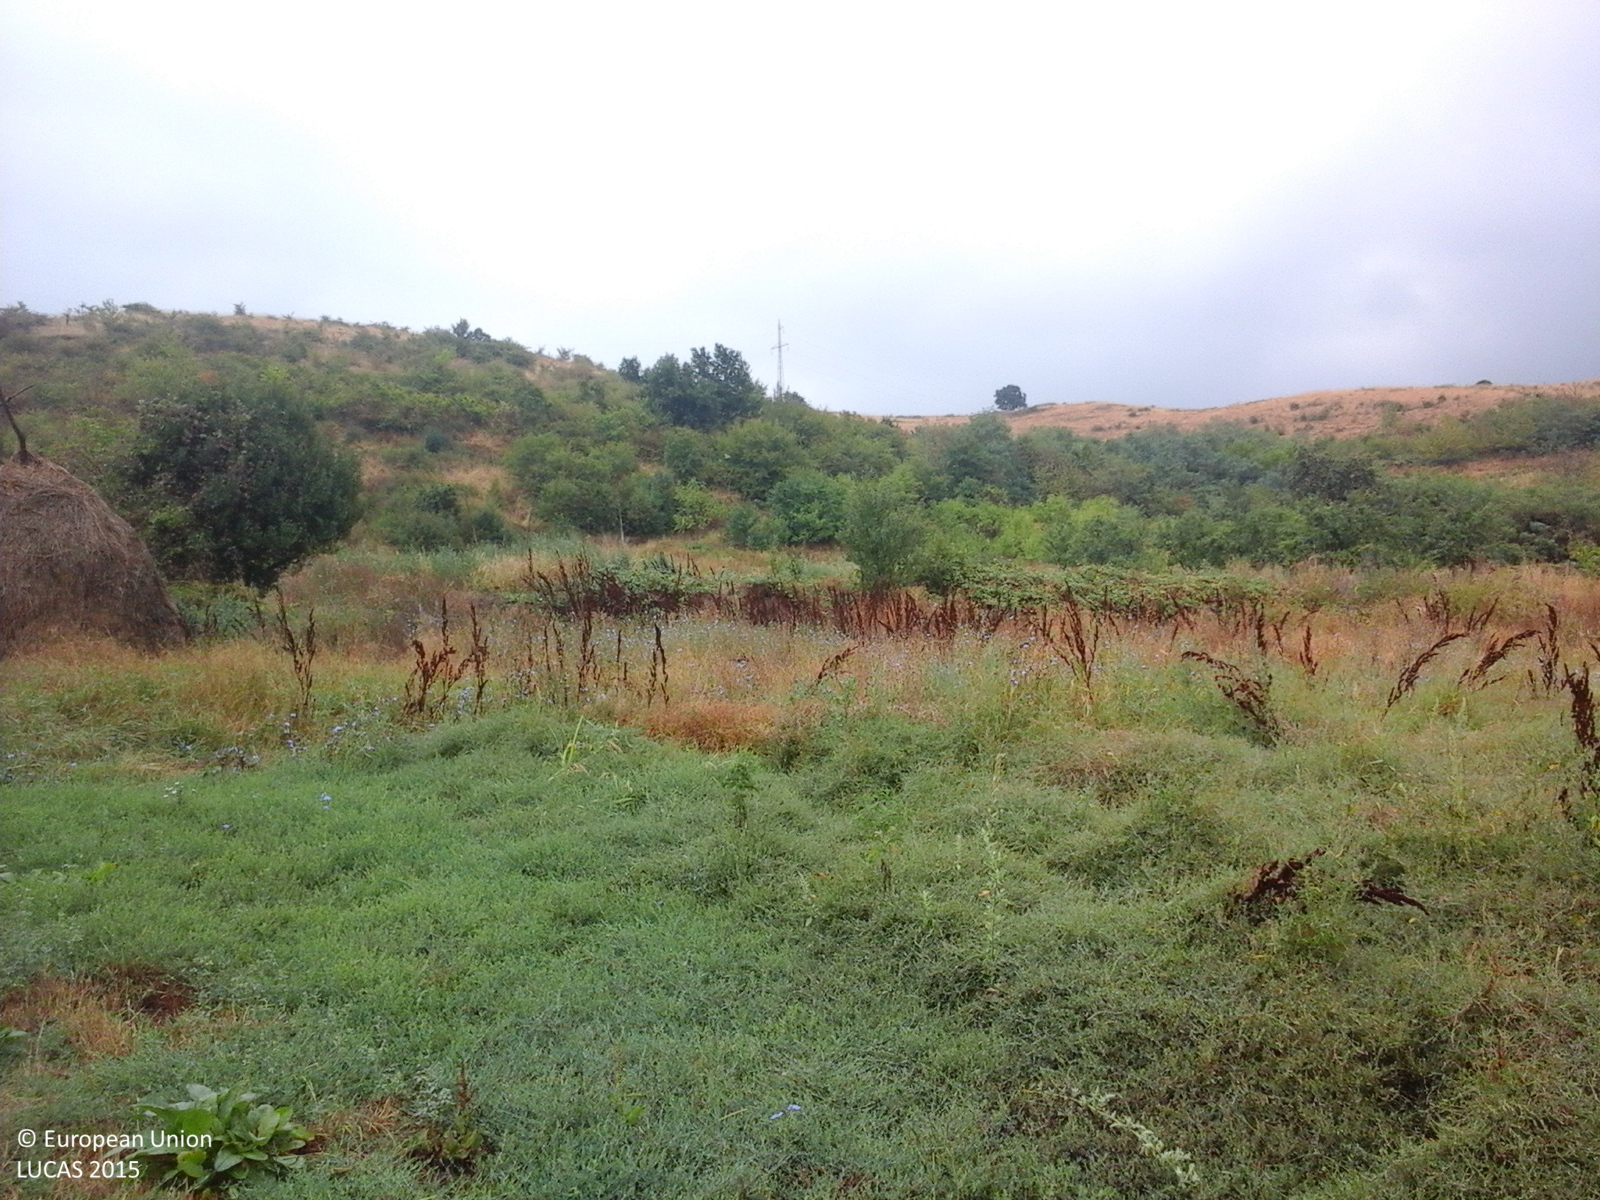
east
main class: Cropland
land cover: Lucerne
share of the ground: > 75 %
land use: Agriculture (excluding fallow land and kitchen gardens)
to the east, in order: Lucerne; Spontaneously vegetated surfaces; Tracks; Spontaneously vegetated surfaces; Tracks; Shrubland with sparse tree cover; Tracks; Grassland with sparse tree/shrub cover
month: August
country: RO
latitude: 44.7521
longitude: 21.6120
